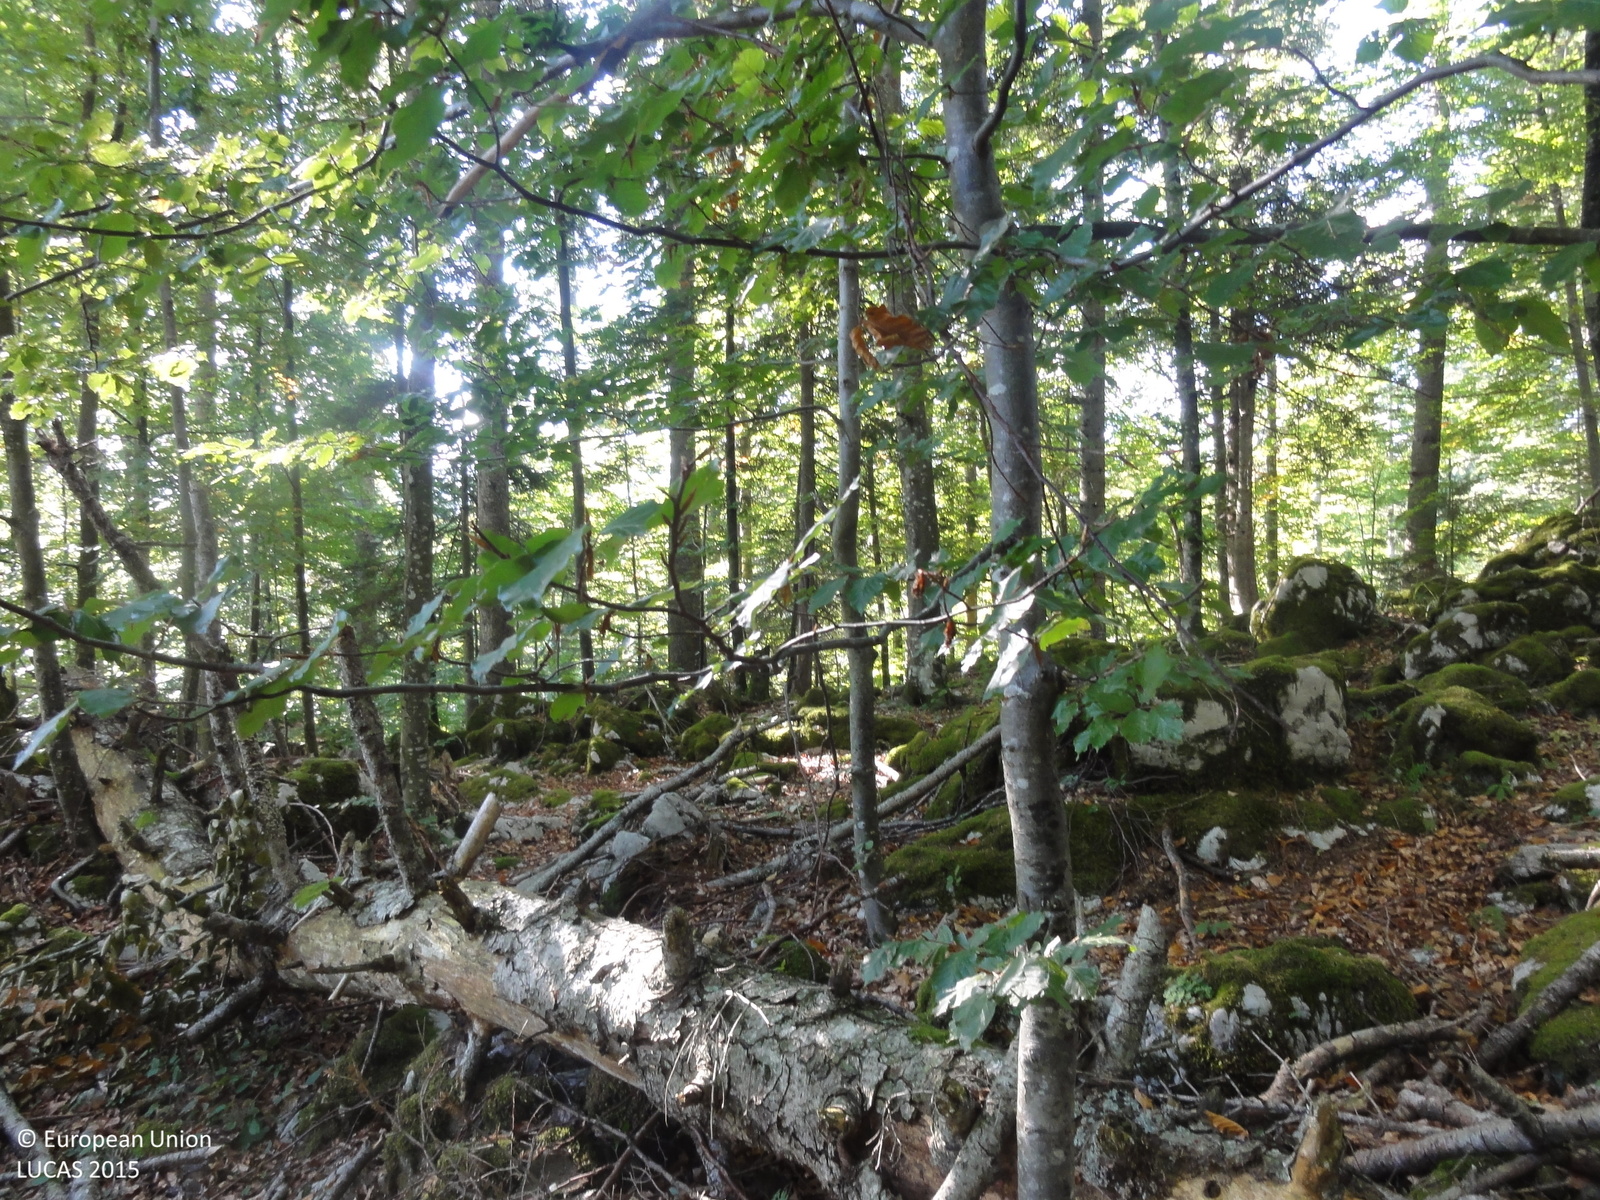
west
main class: Woodland
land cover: Spruce dominated mixed woodland
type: mountainous beech forest
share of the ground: > 75 %
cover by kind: broadleaved forest trees 60 %, coniferous forest trees 30 %, herbaceous plants 5 %, consolidated bare surface 5 %
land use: Forestry
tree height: > 5 m
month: September
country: SI
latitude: 45.6561
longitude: 15.0138
